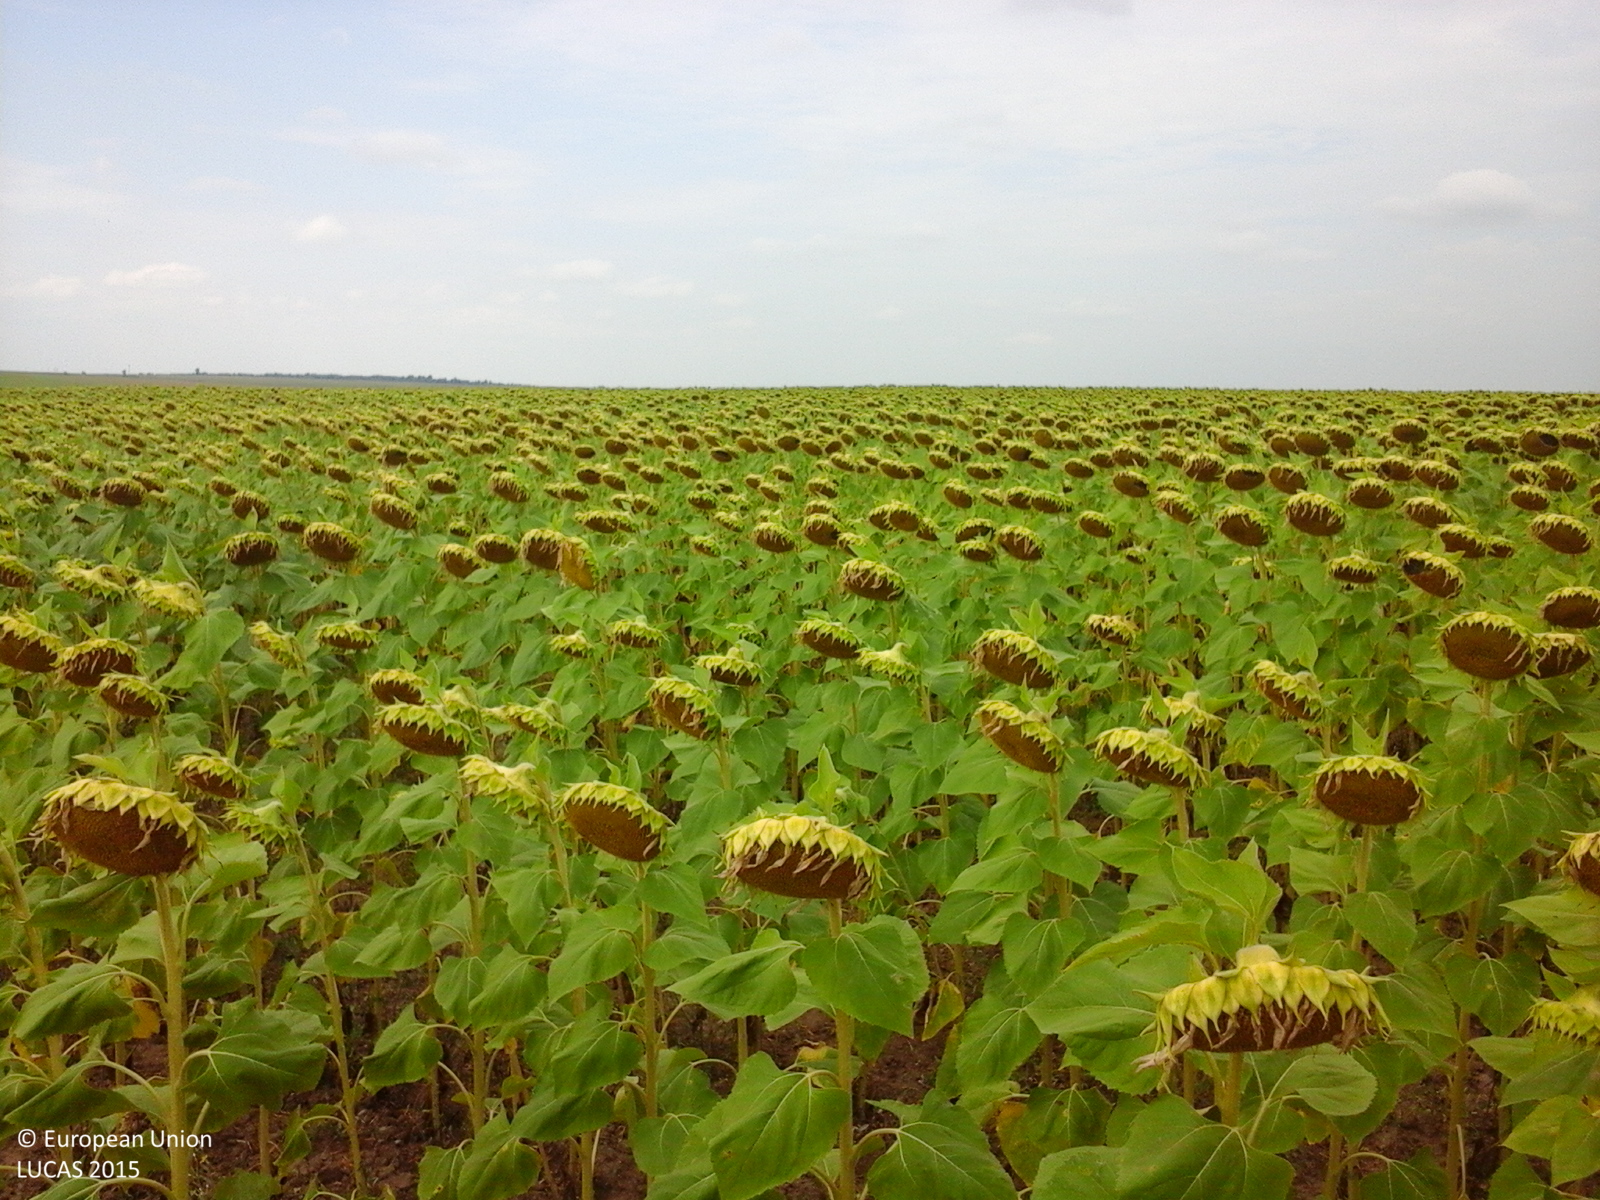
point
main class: Cropland
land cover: Sunflower
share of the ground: > 75 %
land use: Agriculture (excluding fallow land and kitchen gardens)
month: August
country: RO
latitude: 44.8032
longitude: 28.1307
